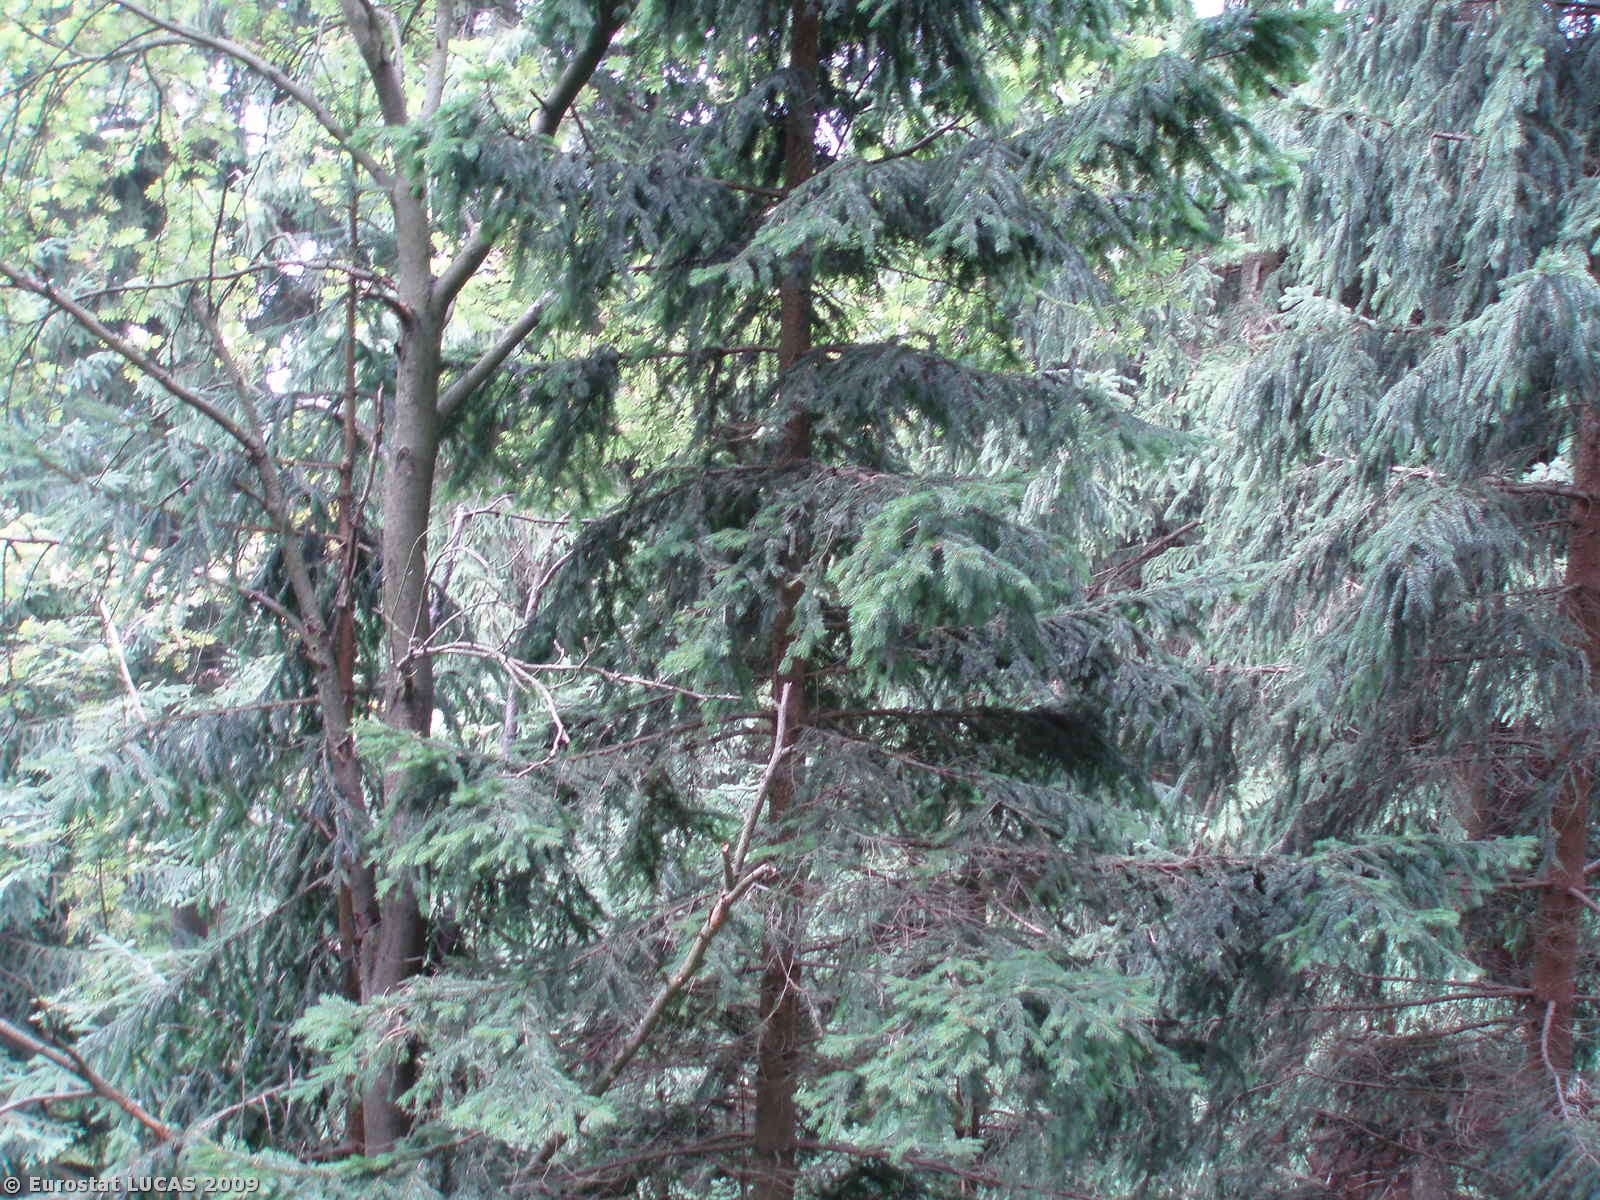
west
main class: Woodland
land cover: Coniferous woodland
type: hemiboreal forest and nemoral coniferous forest and mixed broadleaved-coniferous forest
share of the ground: > 75 %
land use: Forestry
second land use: Nature reserves
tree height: > 5 m
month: July
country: CZ
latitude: 50.7242
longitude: 14.9750
